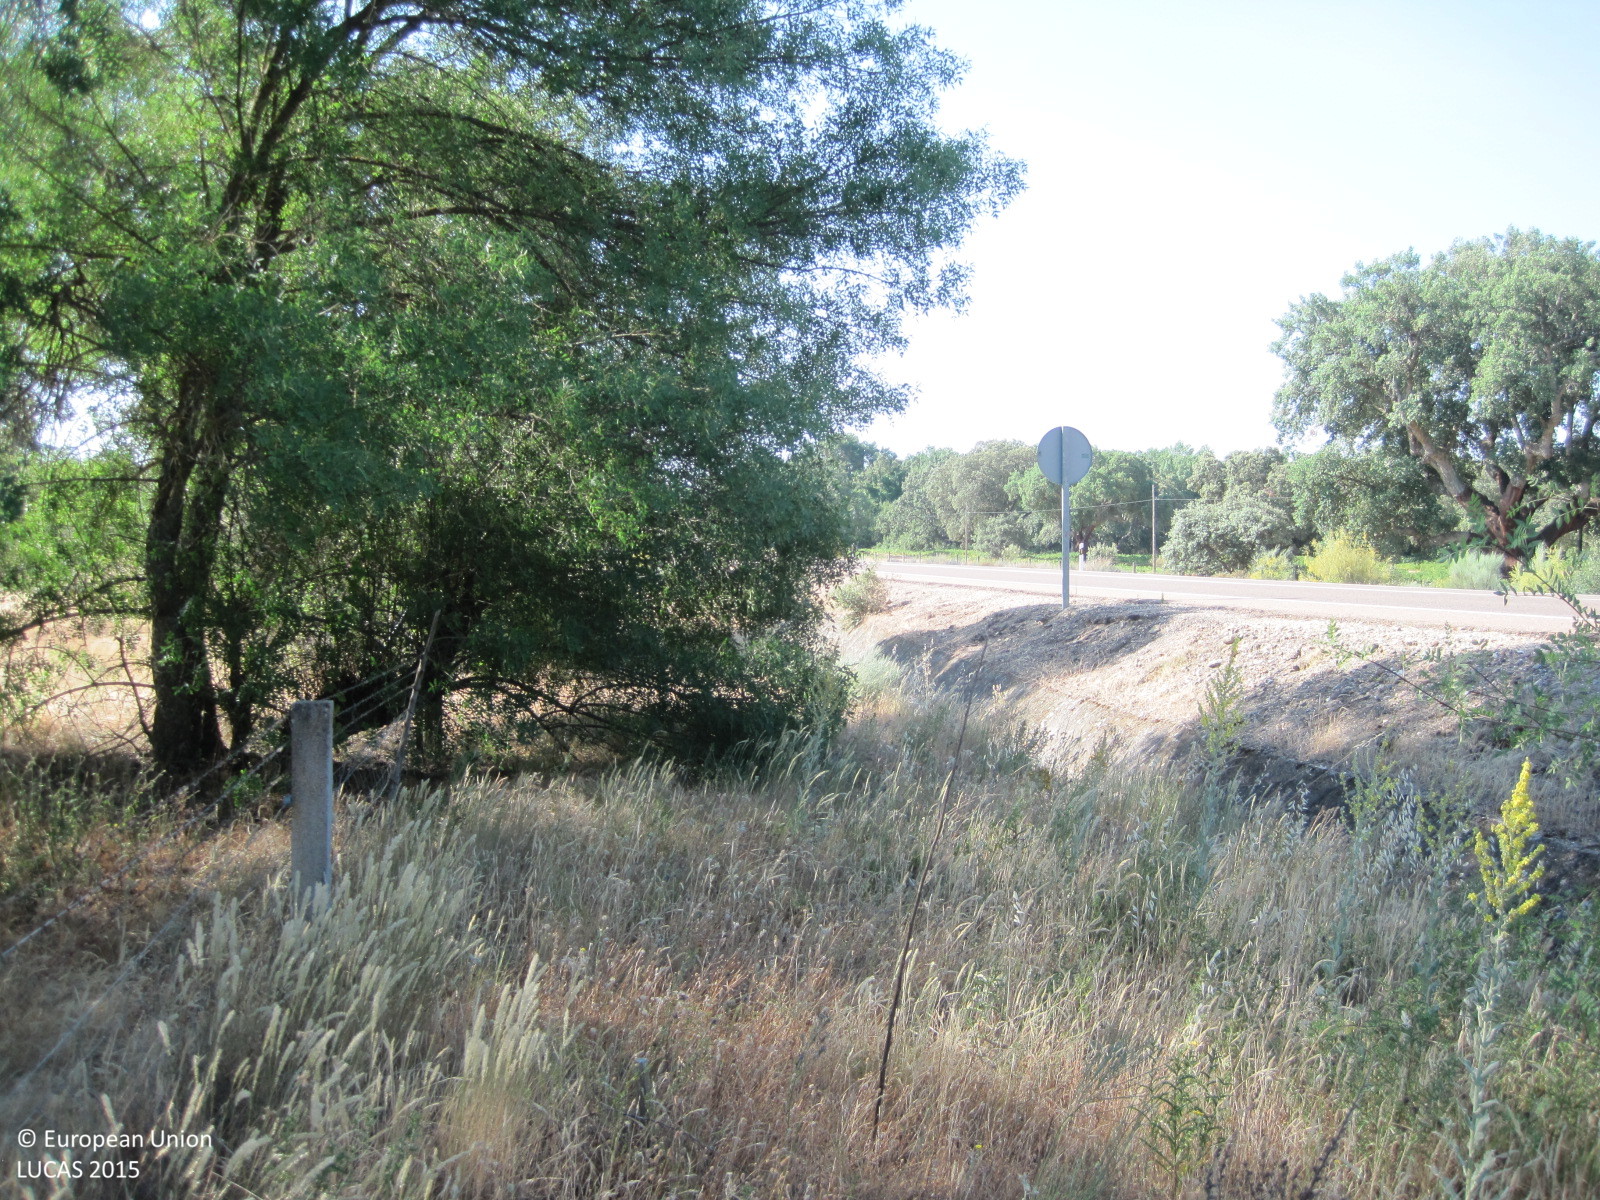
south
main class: Woodland
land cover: Broadleaved woodland
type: broadleaved evergreen forest
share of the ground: 25 - 50 %
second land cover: Grassland without tree/shrub cover
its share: 50 - 75 %
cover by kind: herbaceous plants 55 %, broadleaved forest trees 45 %
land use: Forestry
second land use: Agriculture (excluding fallow land and kitchen gardens)
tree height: > 5 m
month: June
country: ES
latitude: 40.0441
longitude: -4.9957
